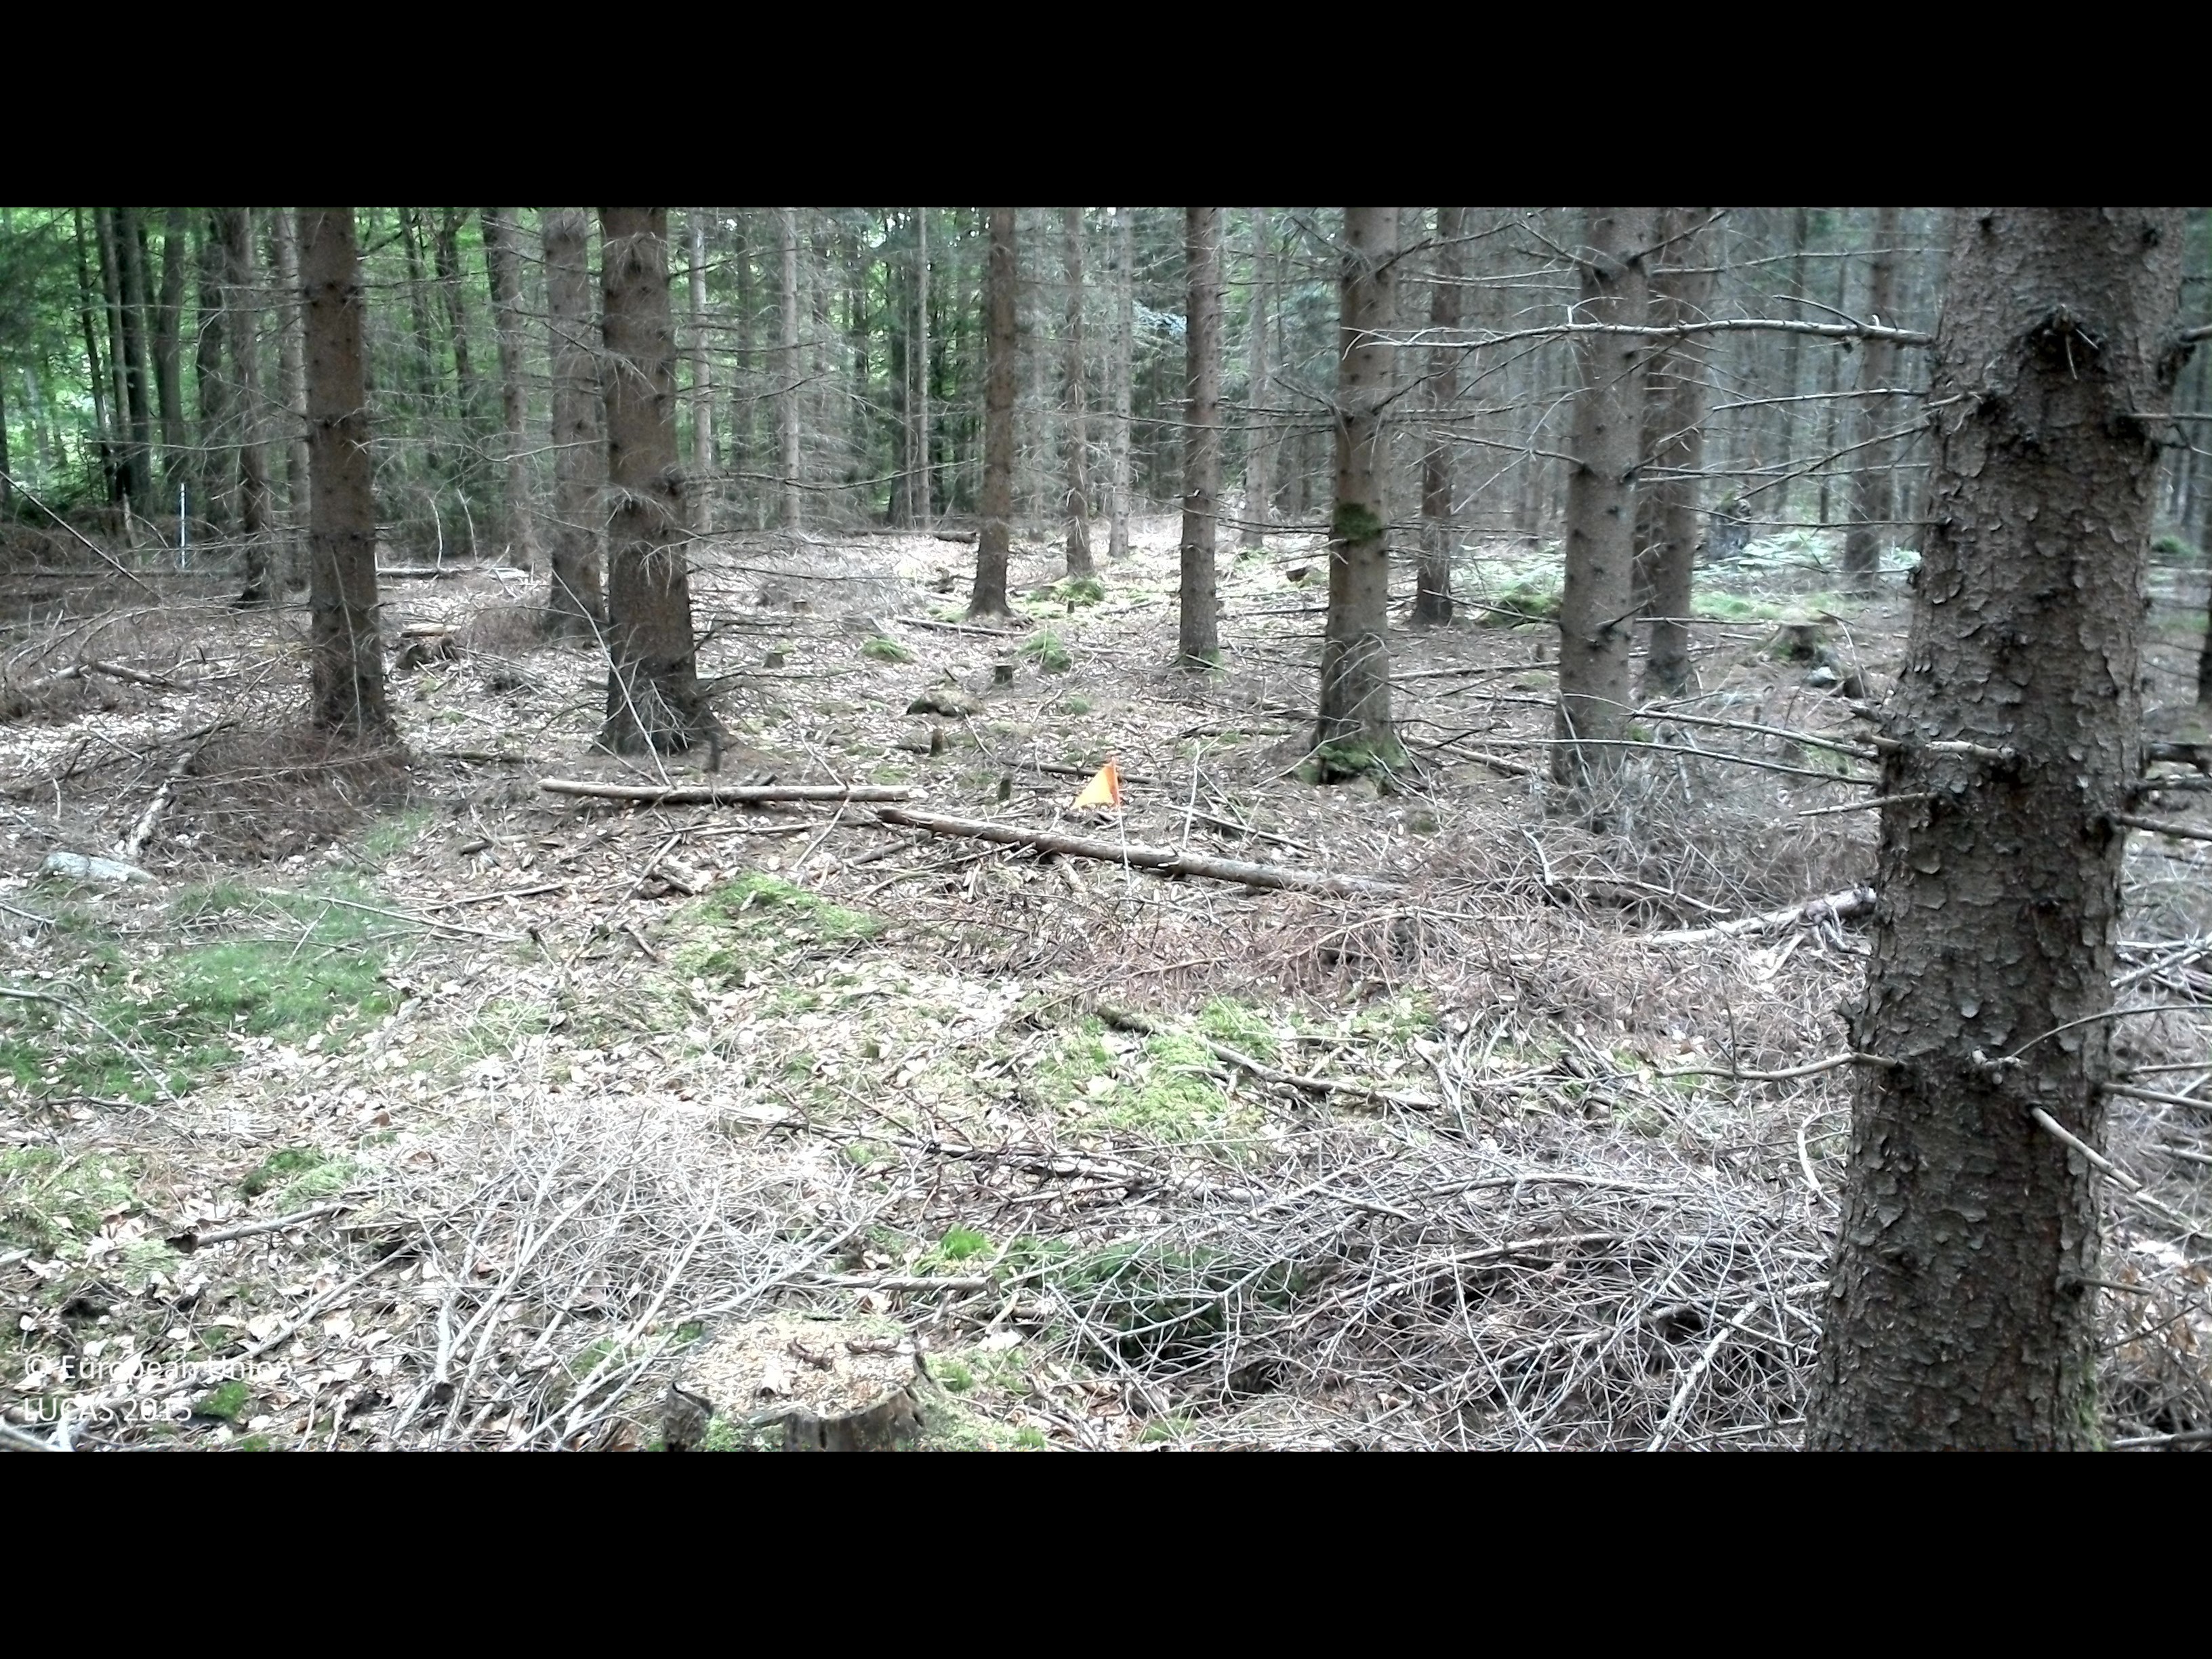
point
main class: Woodland
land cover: Spruce dominated coniferous woodland
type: boreal forest
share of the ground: > 75 %
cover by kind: coniferous forest trees 85 %, lichens and mosses 15 %
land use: Forestry
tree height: > 5 m
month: June
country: SE
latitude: 56.2673
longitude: 15.9263
